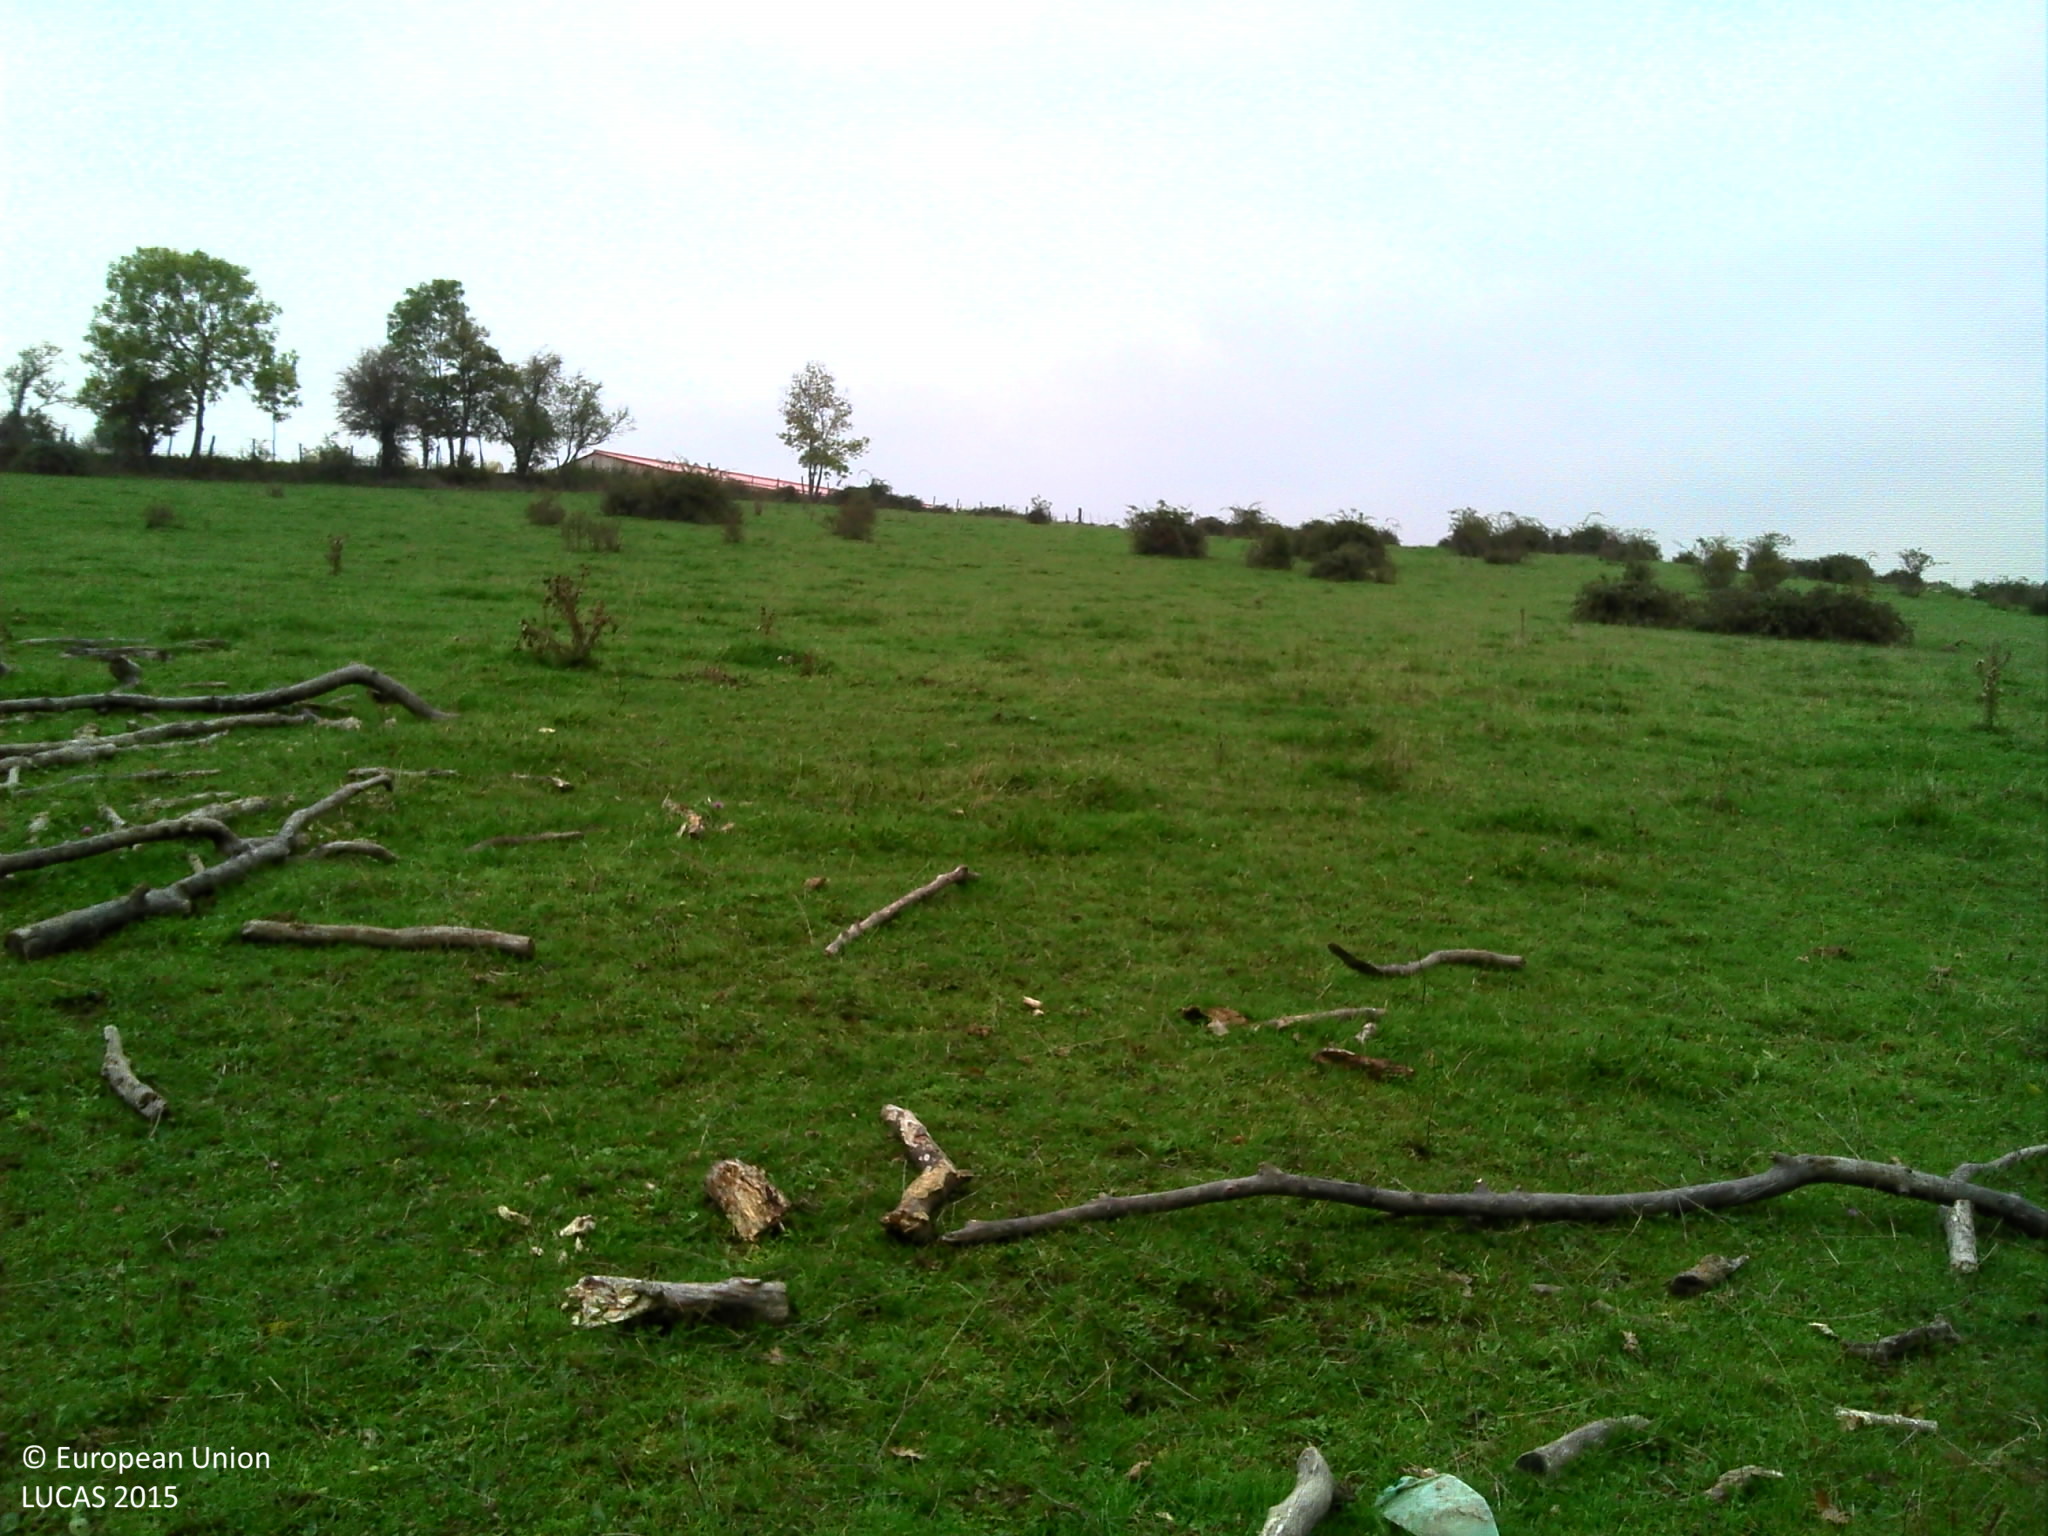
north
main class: Grassland
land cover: Grassland without tree/shrub cover
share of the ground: > 75 %
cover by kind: herbaceous plants 95 %, unconsolidated bare surface 5 %
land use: Agriculture (excluding fallow land and kitchen gardens)
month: October
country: FR
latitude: 45.9978
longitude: 3.0393
